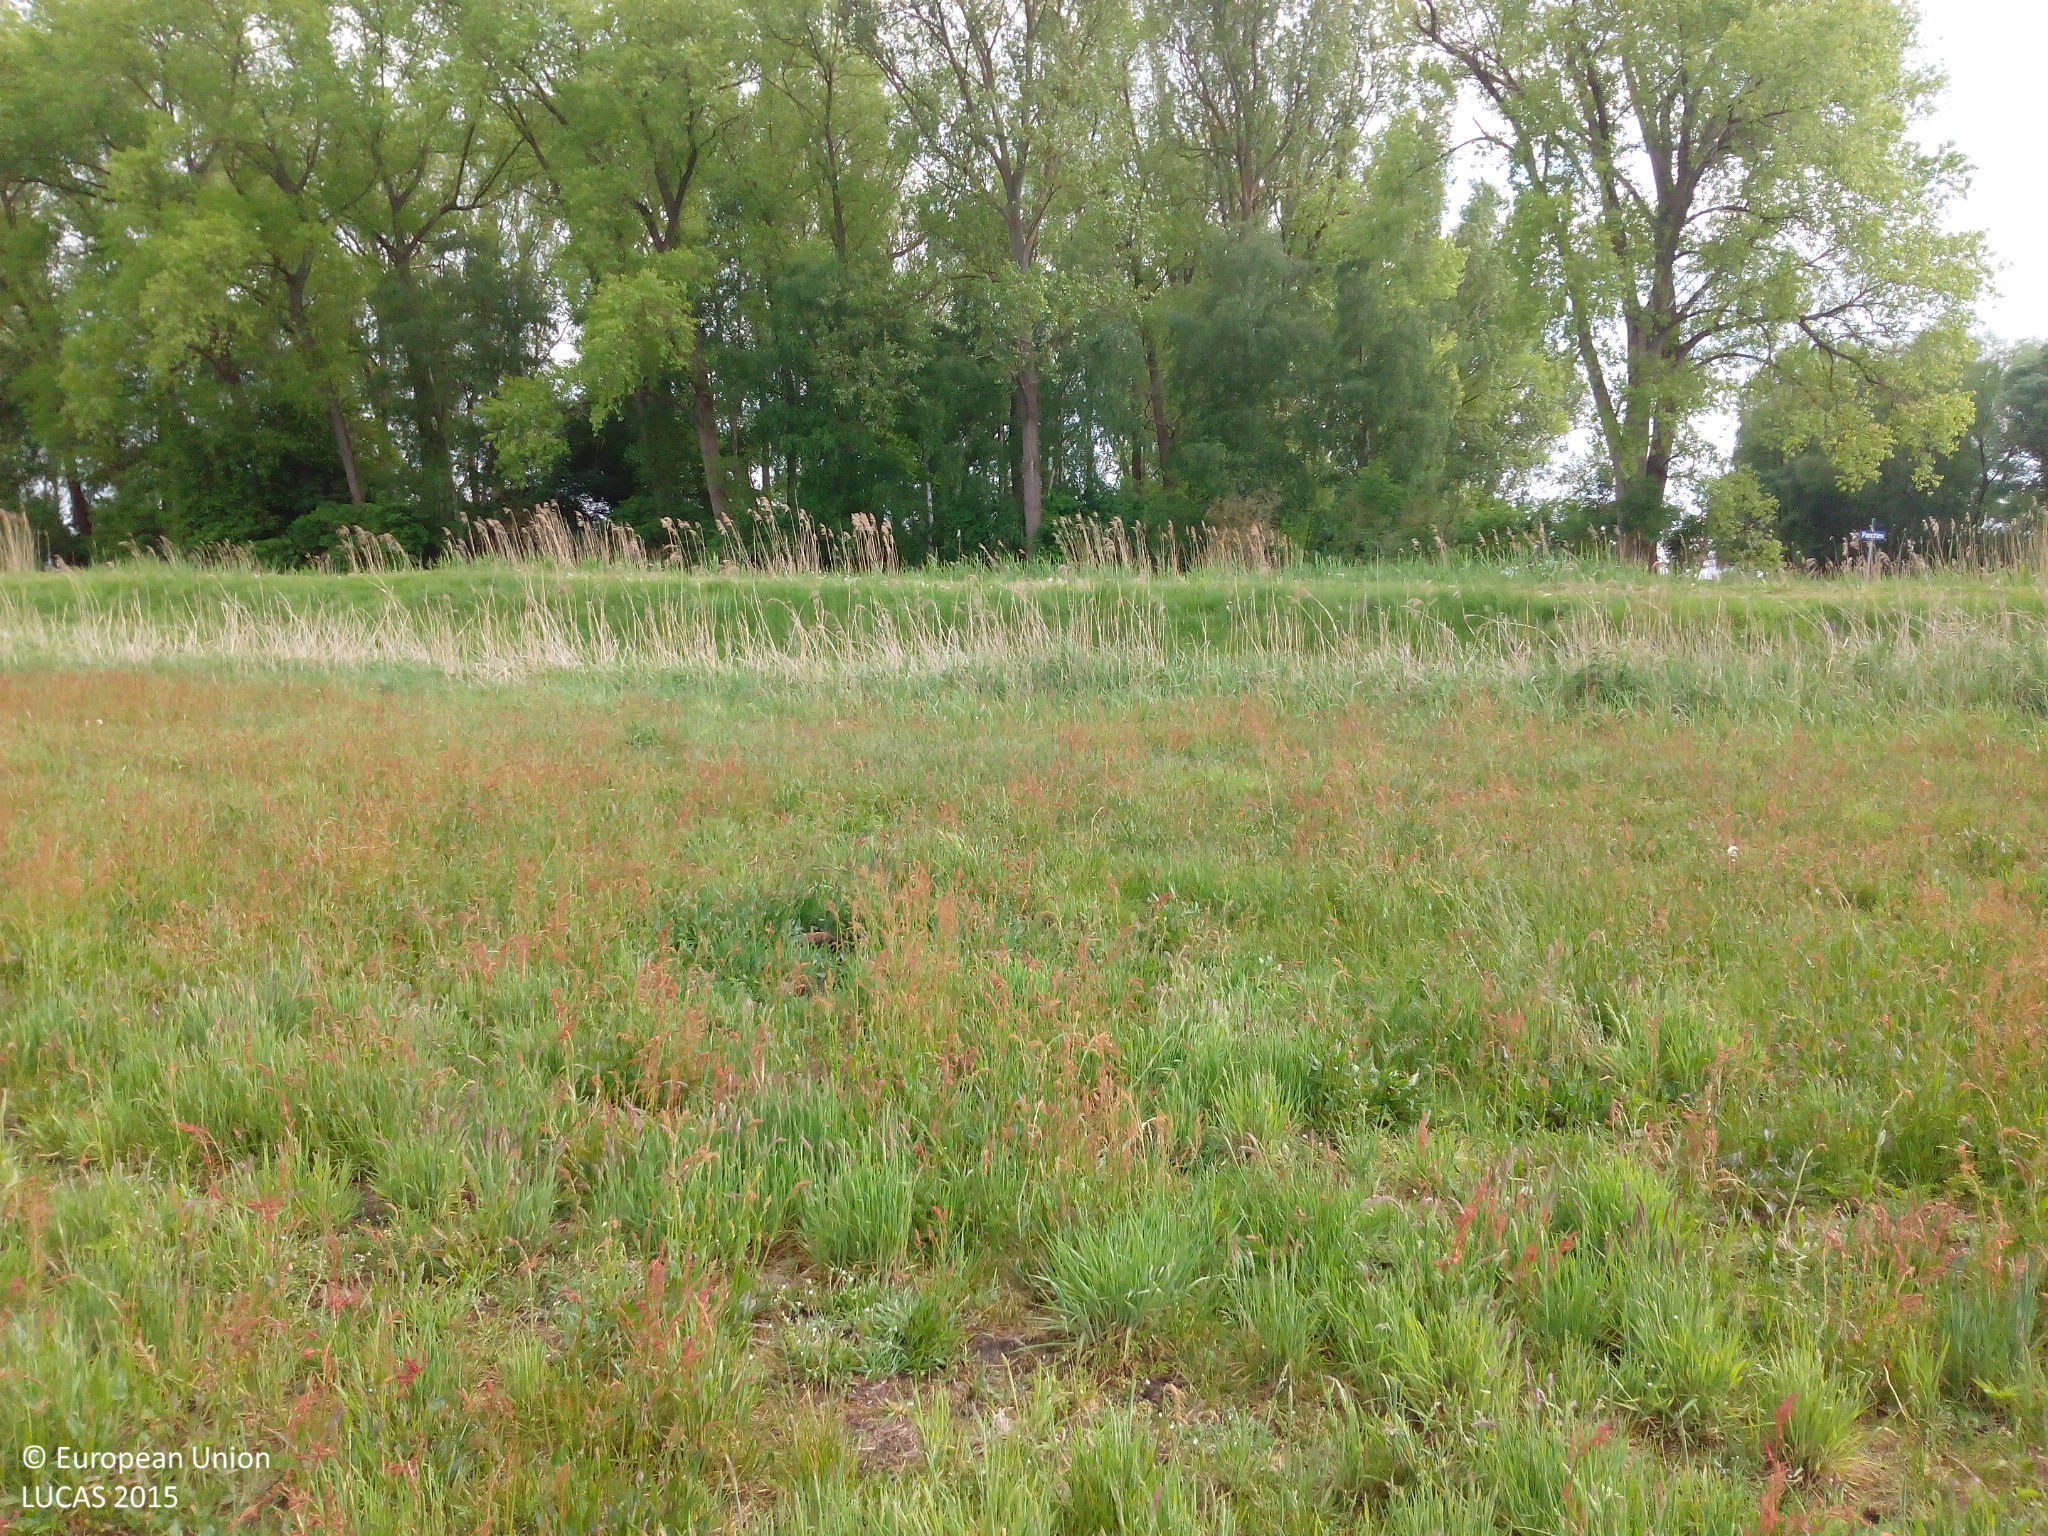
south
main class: Grassland
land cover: Grassland without tree/shrub cover
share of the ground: > 75 %
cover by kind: herbaceous plants 100 %
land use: Agriculture (excluding fallow land and kitchen gardens)
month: May
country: DE
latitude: 53.4627
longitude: 11.6411
